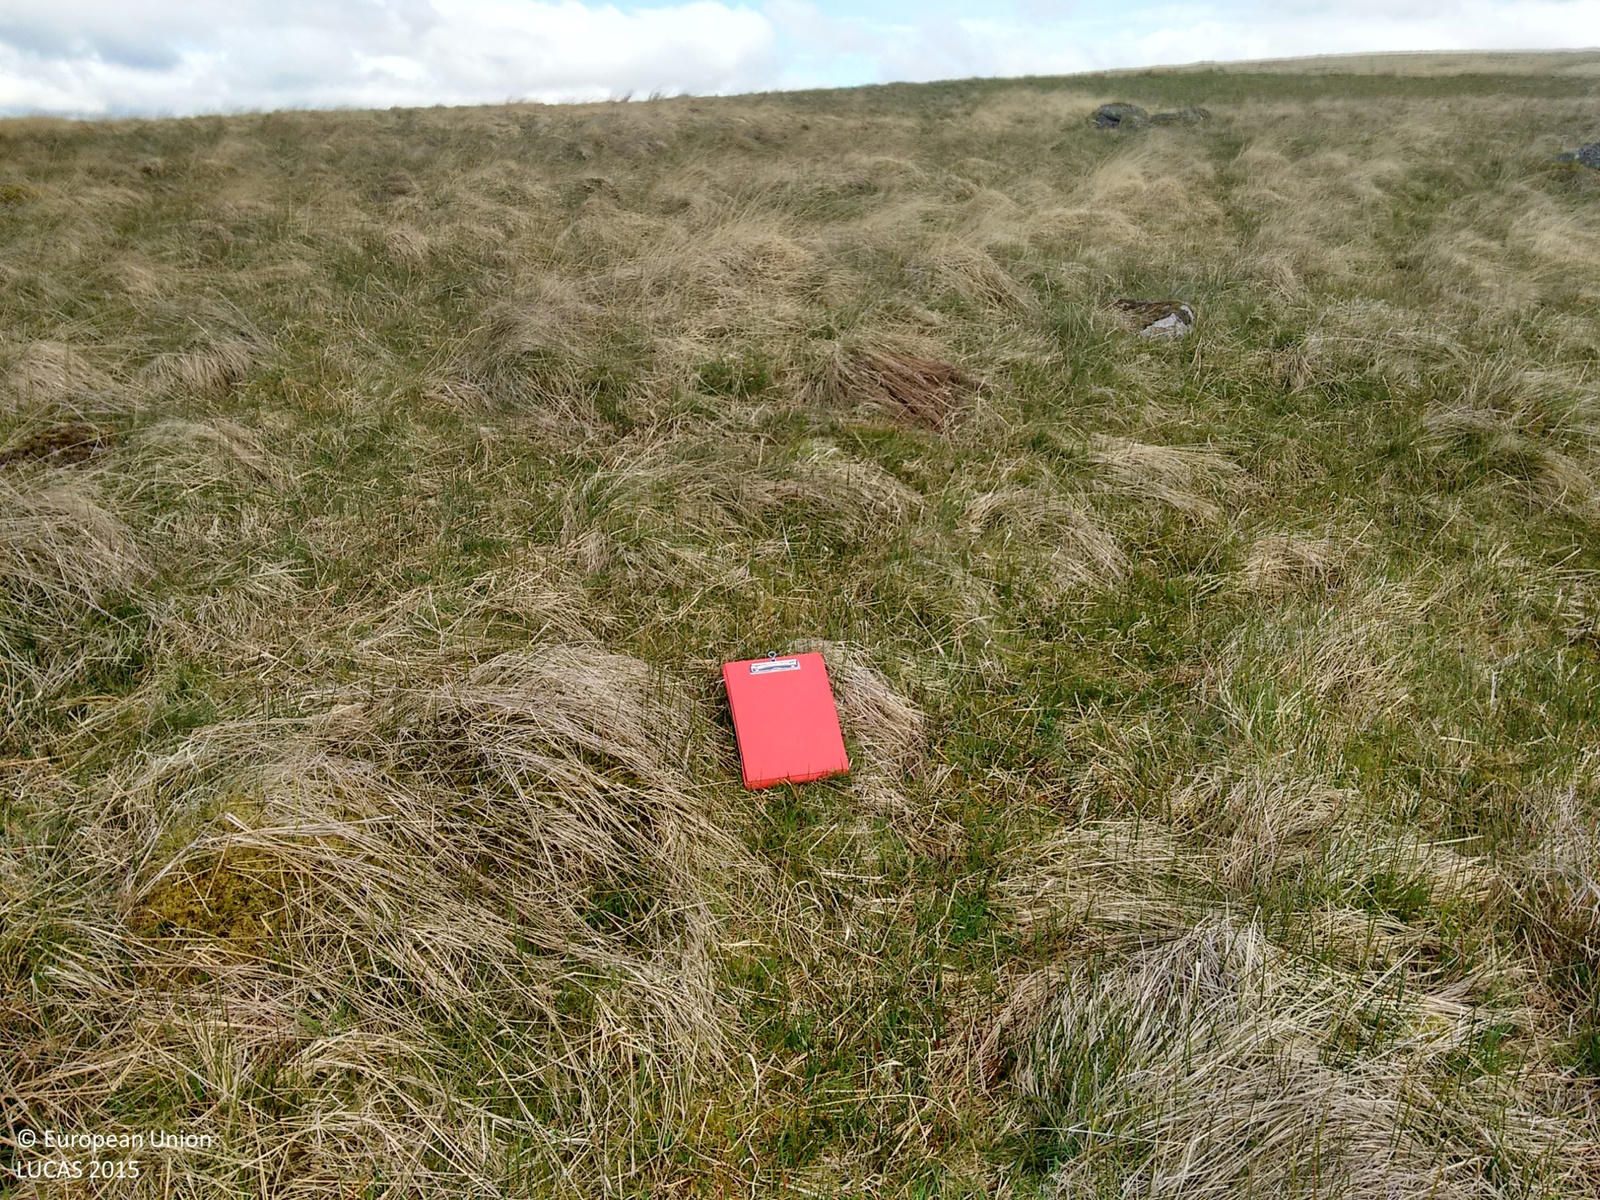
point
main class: Grassland
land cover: Grassland without tree/shrub cover
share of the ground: > 75 %
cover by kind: herbaceous plants 80 %, lichens and mosses 20 %
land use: Agriculture (excluding fallow land and kitchen gardens)
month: May
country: GB
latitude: 56.3139
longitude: -3.9721
